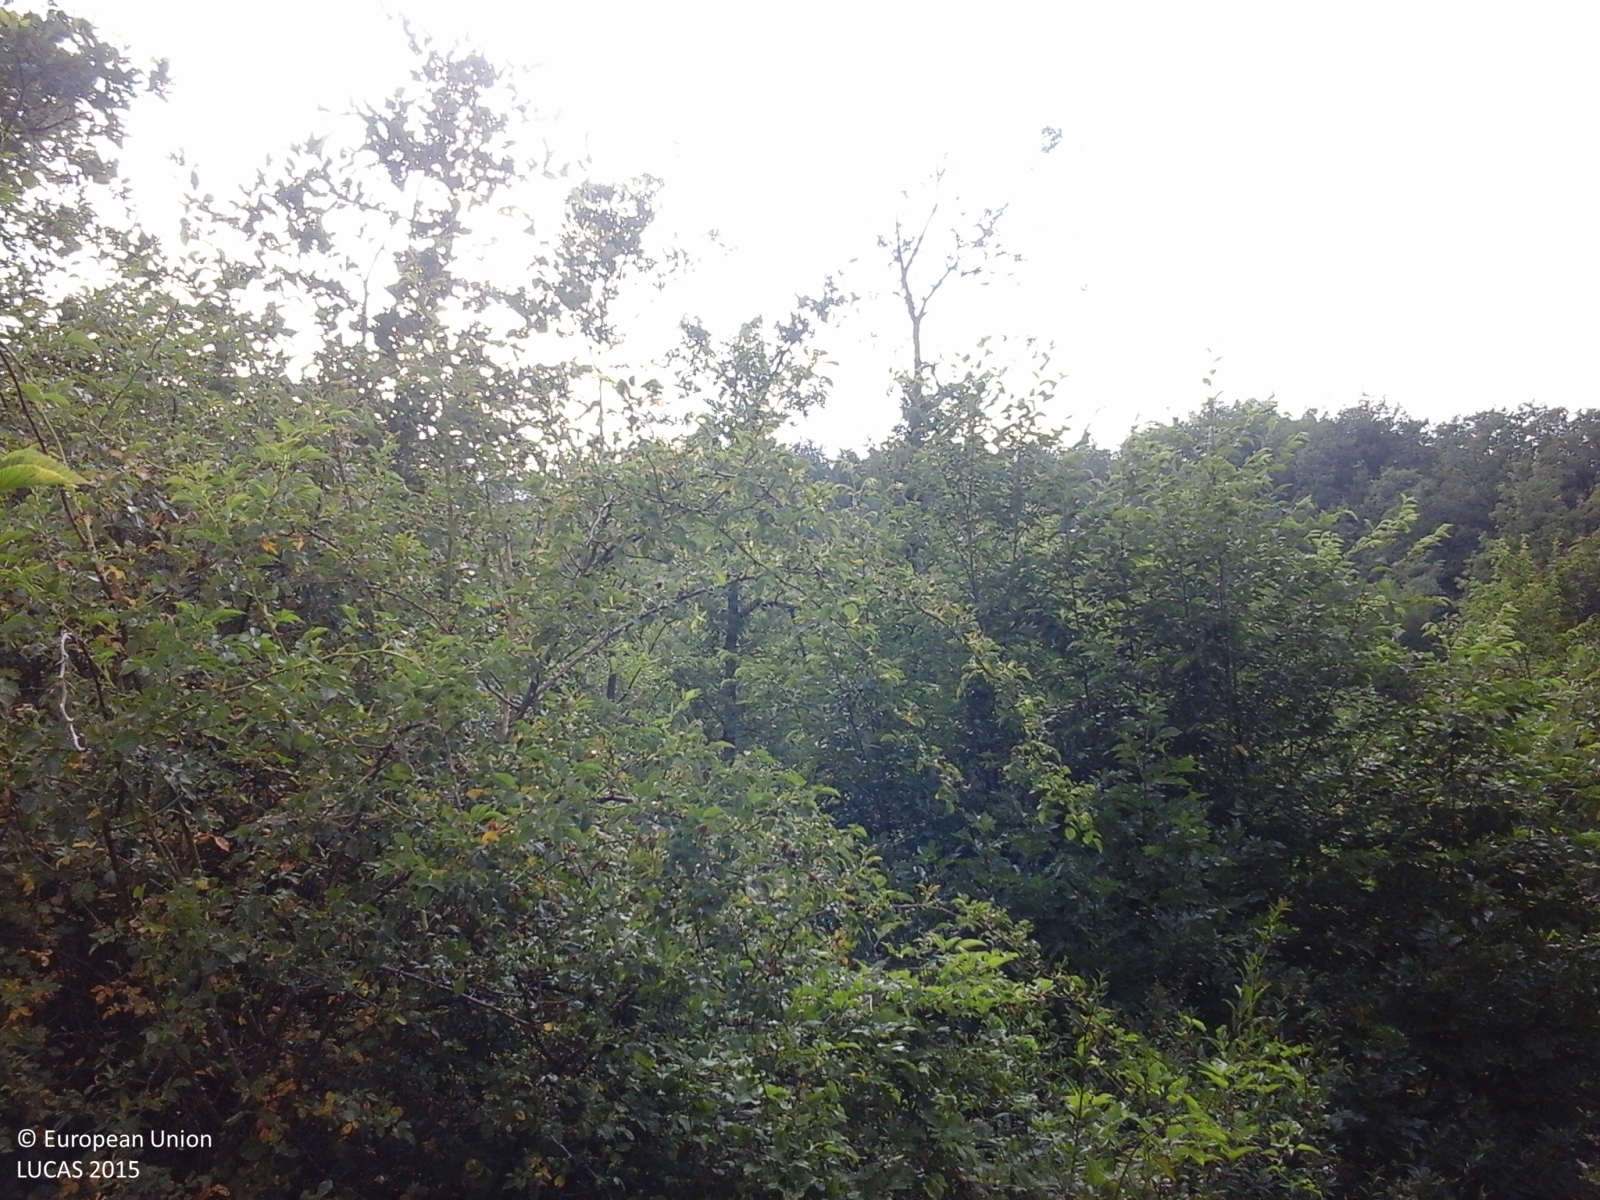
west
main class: Woodland
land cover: Broadleaved woodland
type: thermophilous deciduous forest
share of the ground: > 75 %
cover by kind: broadleaved forest trees 75 %, herbaceous plants 15 %, shrubs 10 %
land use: Agriculture (excluding fallow land and kitchen gardens)
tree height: < 5 m
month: July
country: IT
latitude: 44.7615
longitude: 9.1049
